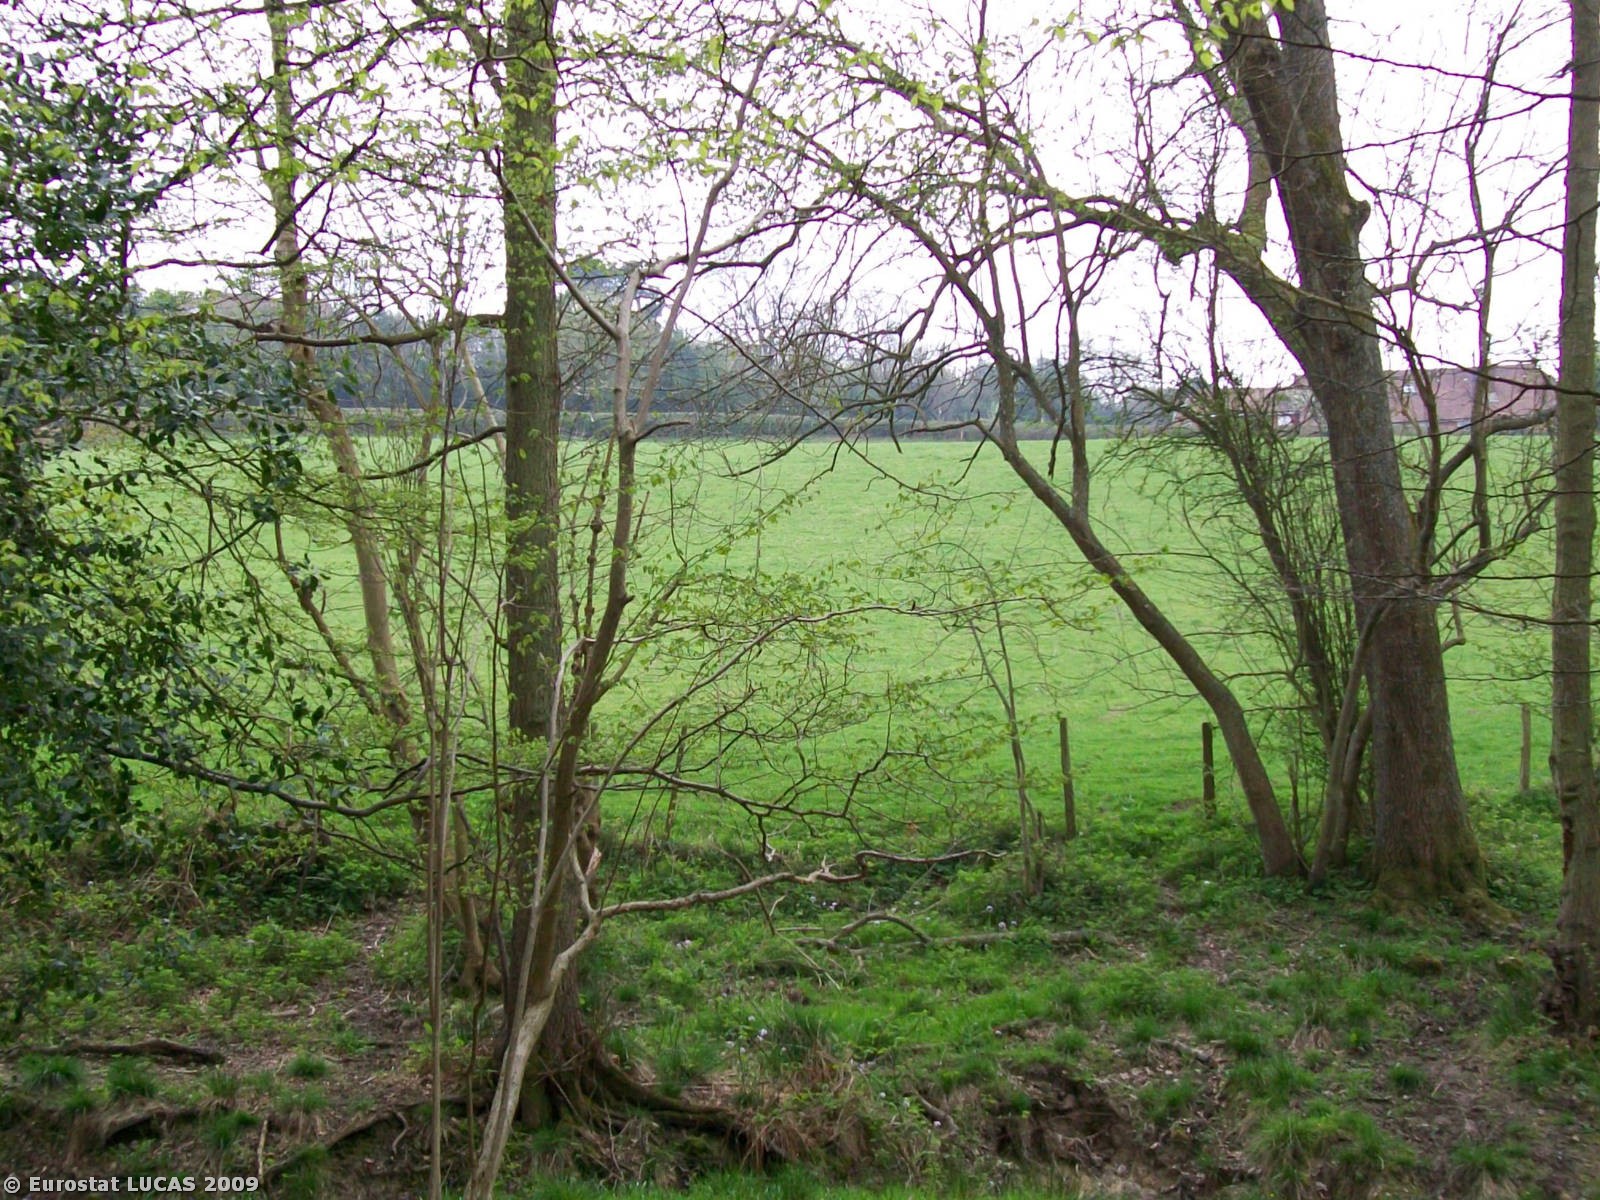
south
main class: Woodland
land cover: Mixed woodland
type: mesophytic deciduous forest
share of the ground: > 75 %
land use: Forestry
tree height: > 5 m
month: April
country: GB
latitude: 50.9523
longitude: 0.3622
